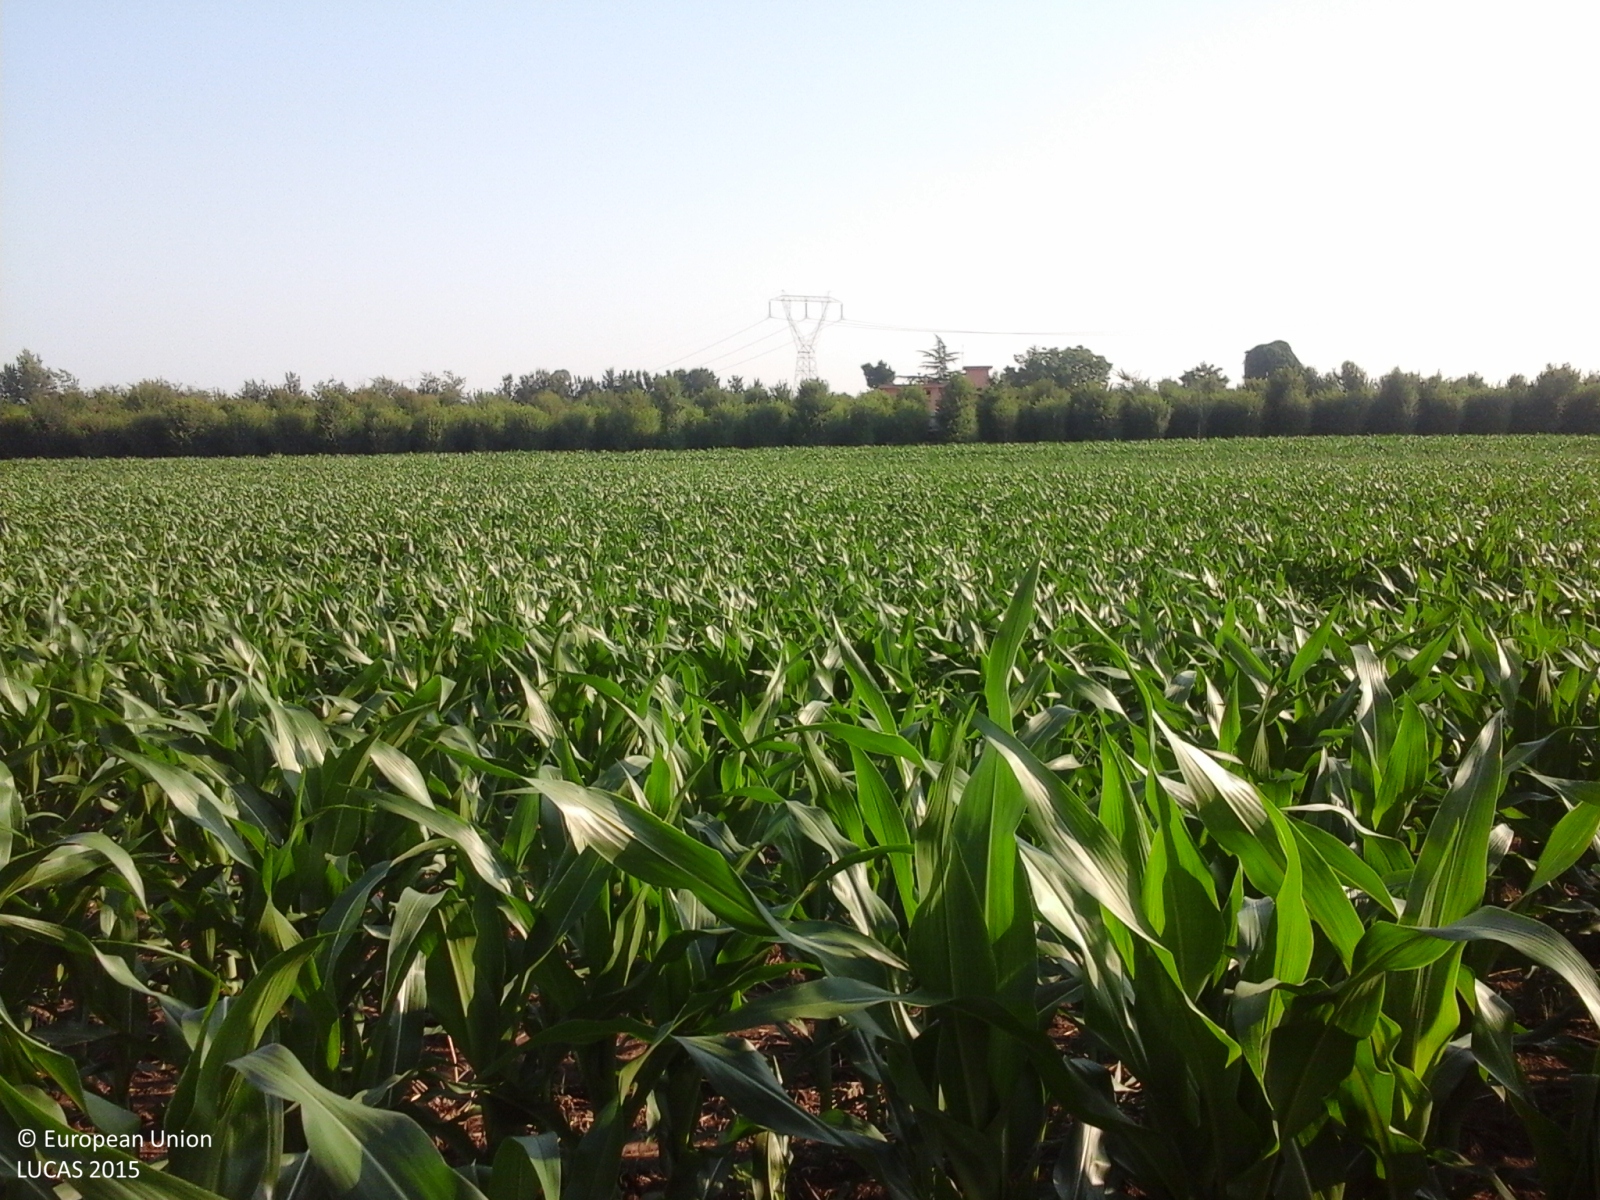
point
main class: Cropland
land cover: Maize
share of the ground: > 75 %
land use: Agriculture (excluding fallow land and kitchen gardens)
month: July
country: IT
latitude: 41.5304
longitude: 12.8054
